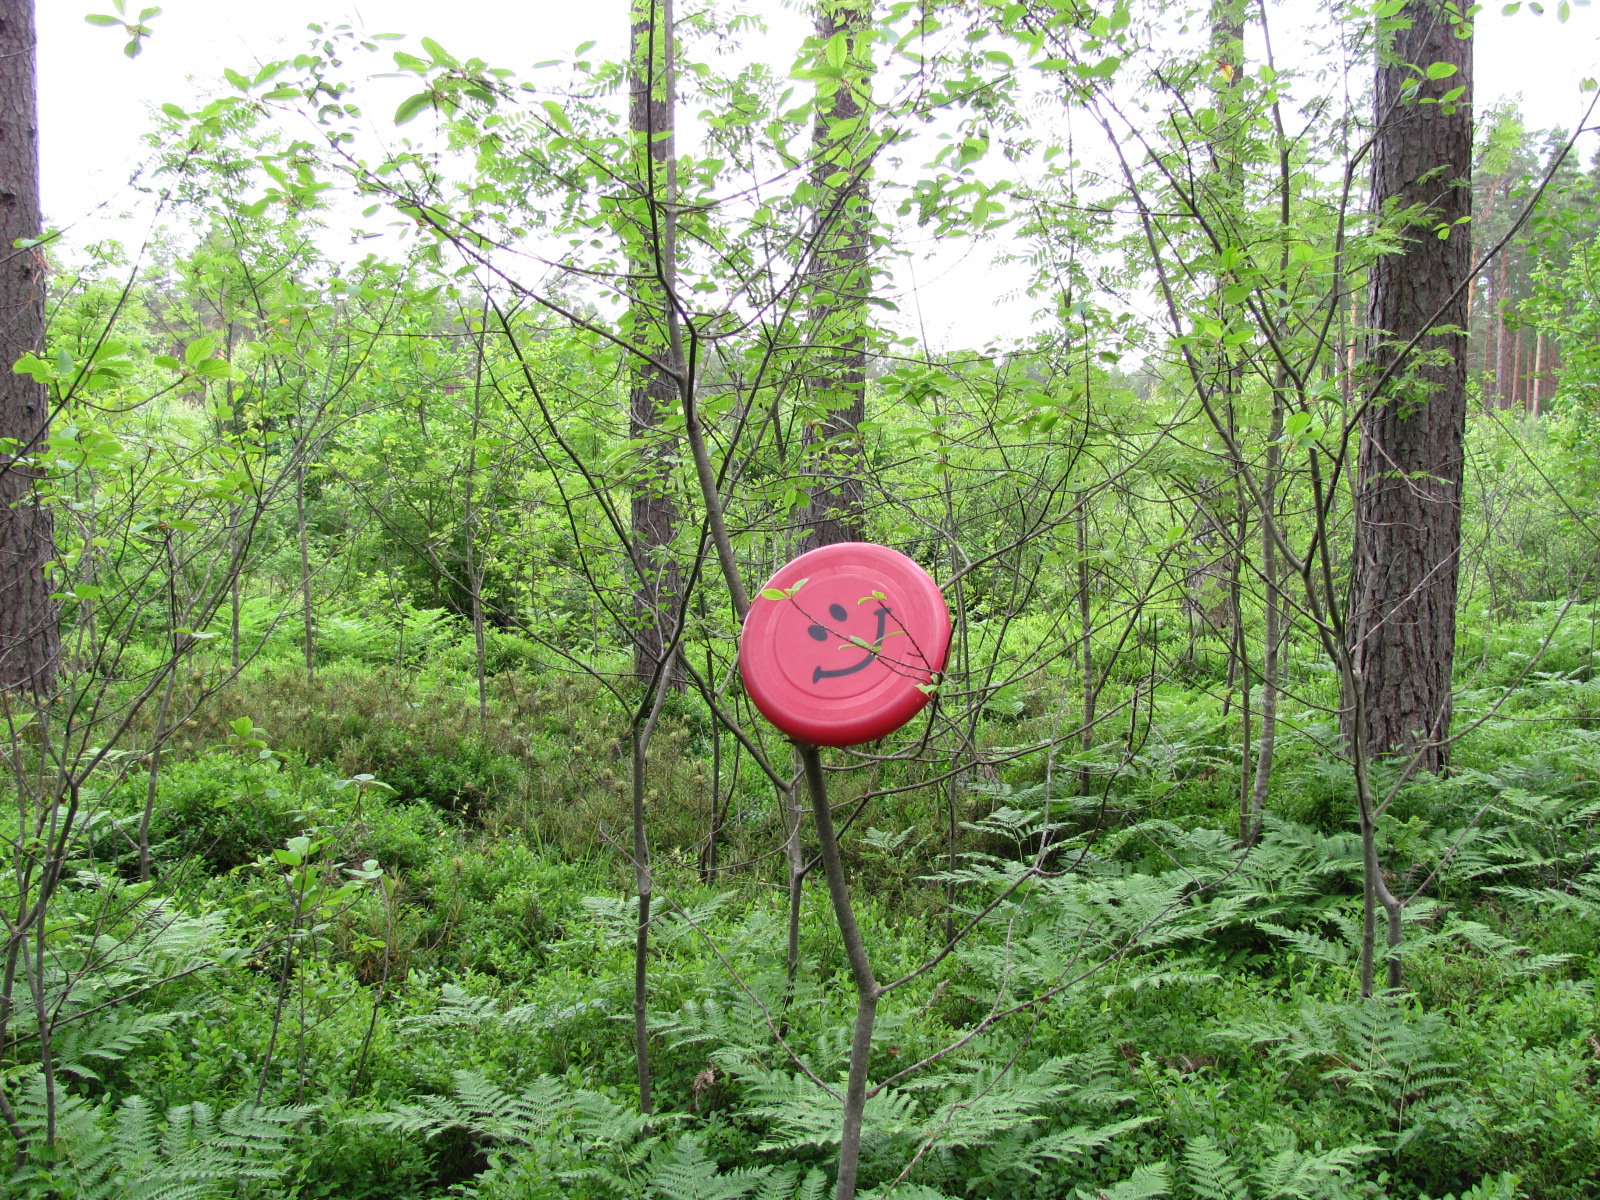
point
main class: Woodland
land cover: Pine dominated mixed woodland
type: hemiboreal forest and nemoral coniferous forest and mixed broadleaved-coniferous forest
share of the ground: > 75 %
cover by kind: coniferous forest trees 60 %, broadleaved forest trees 25 %, herbaceous plants 15 %
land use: Forestry
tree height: > 5 m
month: June
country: LV
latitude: 56.9078
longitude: 23.8920
